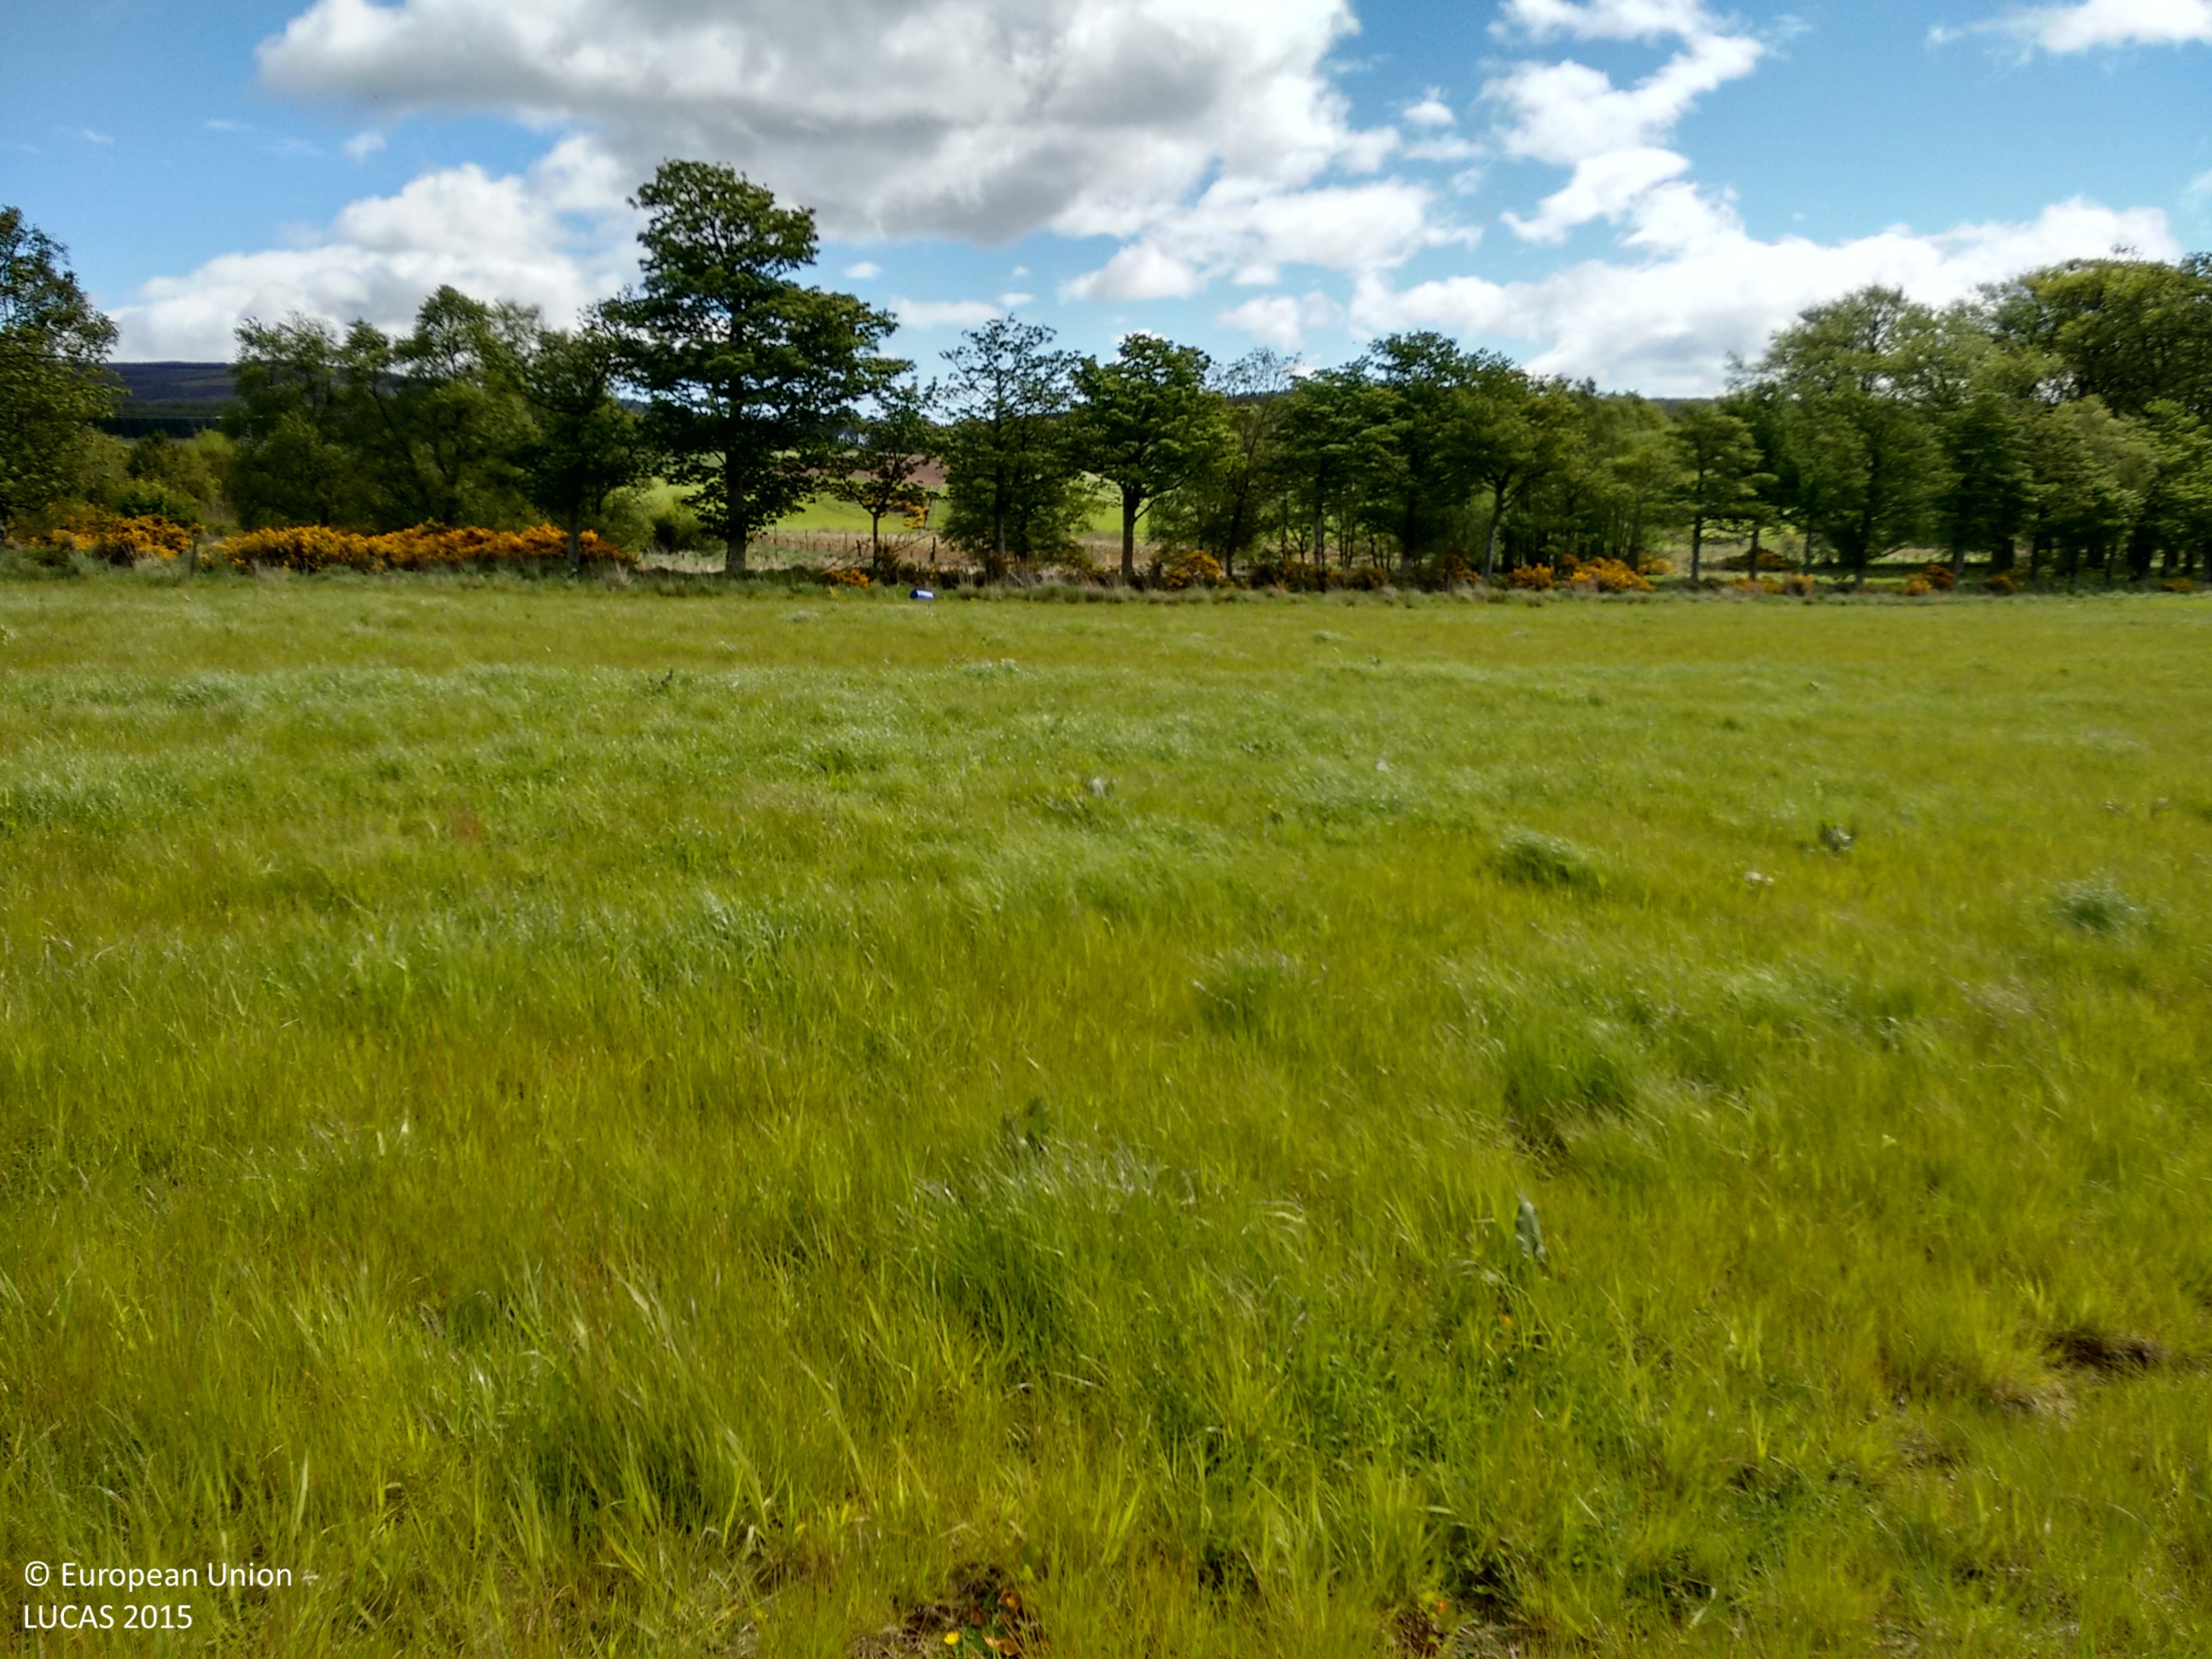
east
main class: Cropland
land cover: Temporary grasslands
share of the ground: > 75 %
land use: Agriculture (excluding fallow land and kitchen gardens)
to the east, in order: Temporary grasslands; Spontaneously vegetated surfaces; Ditches and canals; Fences; Shrubland without tree cover; Lines of trees; Grassland without tree/shrub cover; Spontaneously vegetated surfaces; Ditches and canals; Fences; Grass margins; Tracks; Grass margins; Fences; Grass margins; Other bare soil; Nurseries
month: June
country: GB
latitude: 56.8781
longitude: -2.5770
